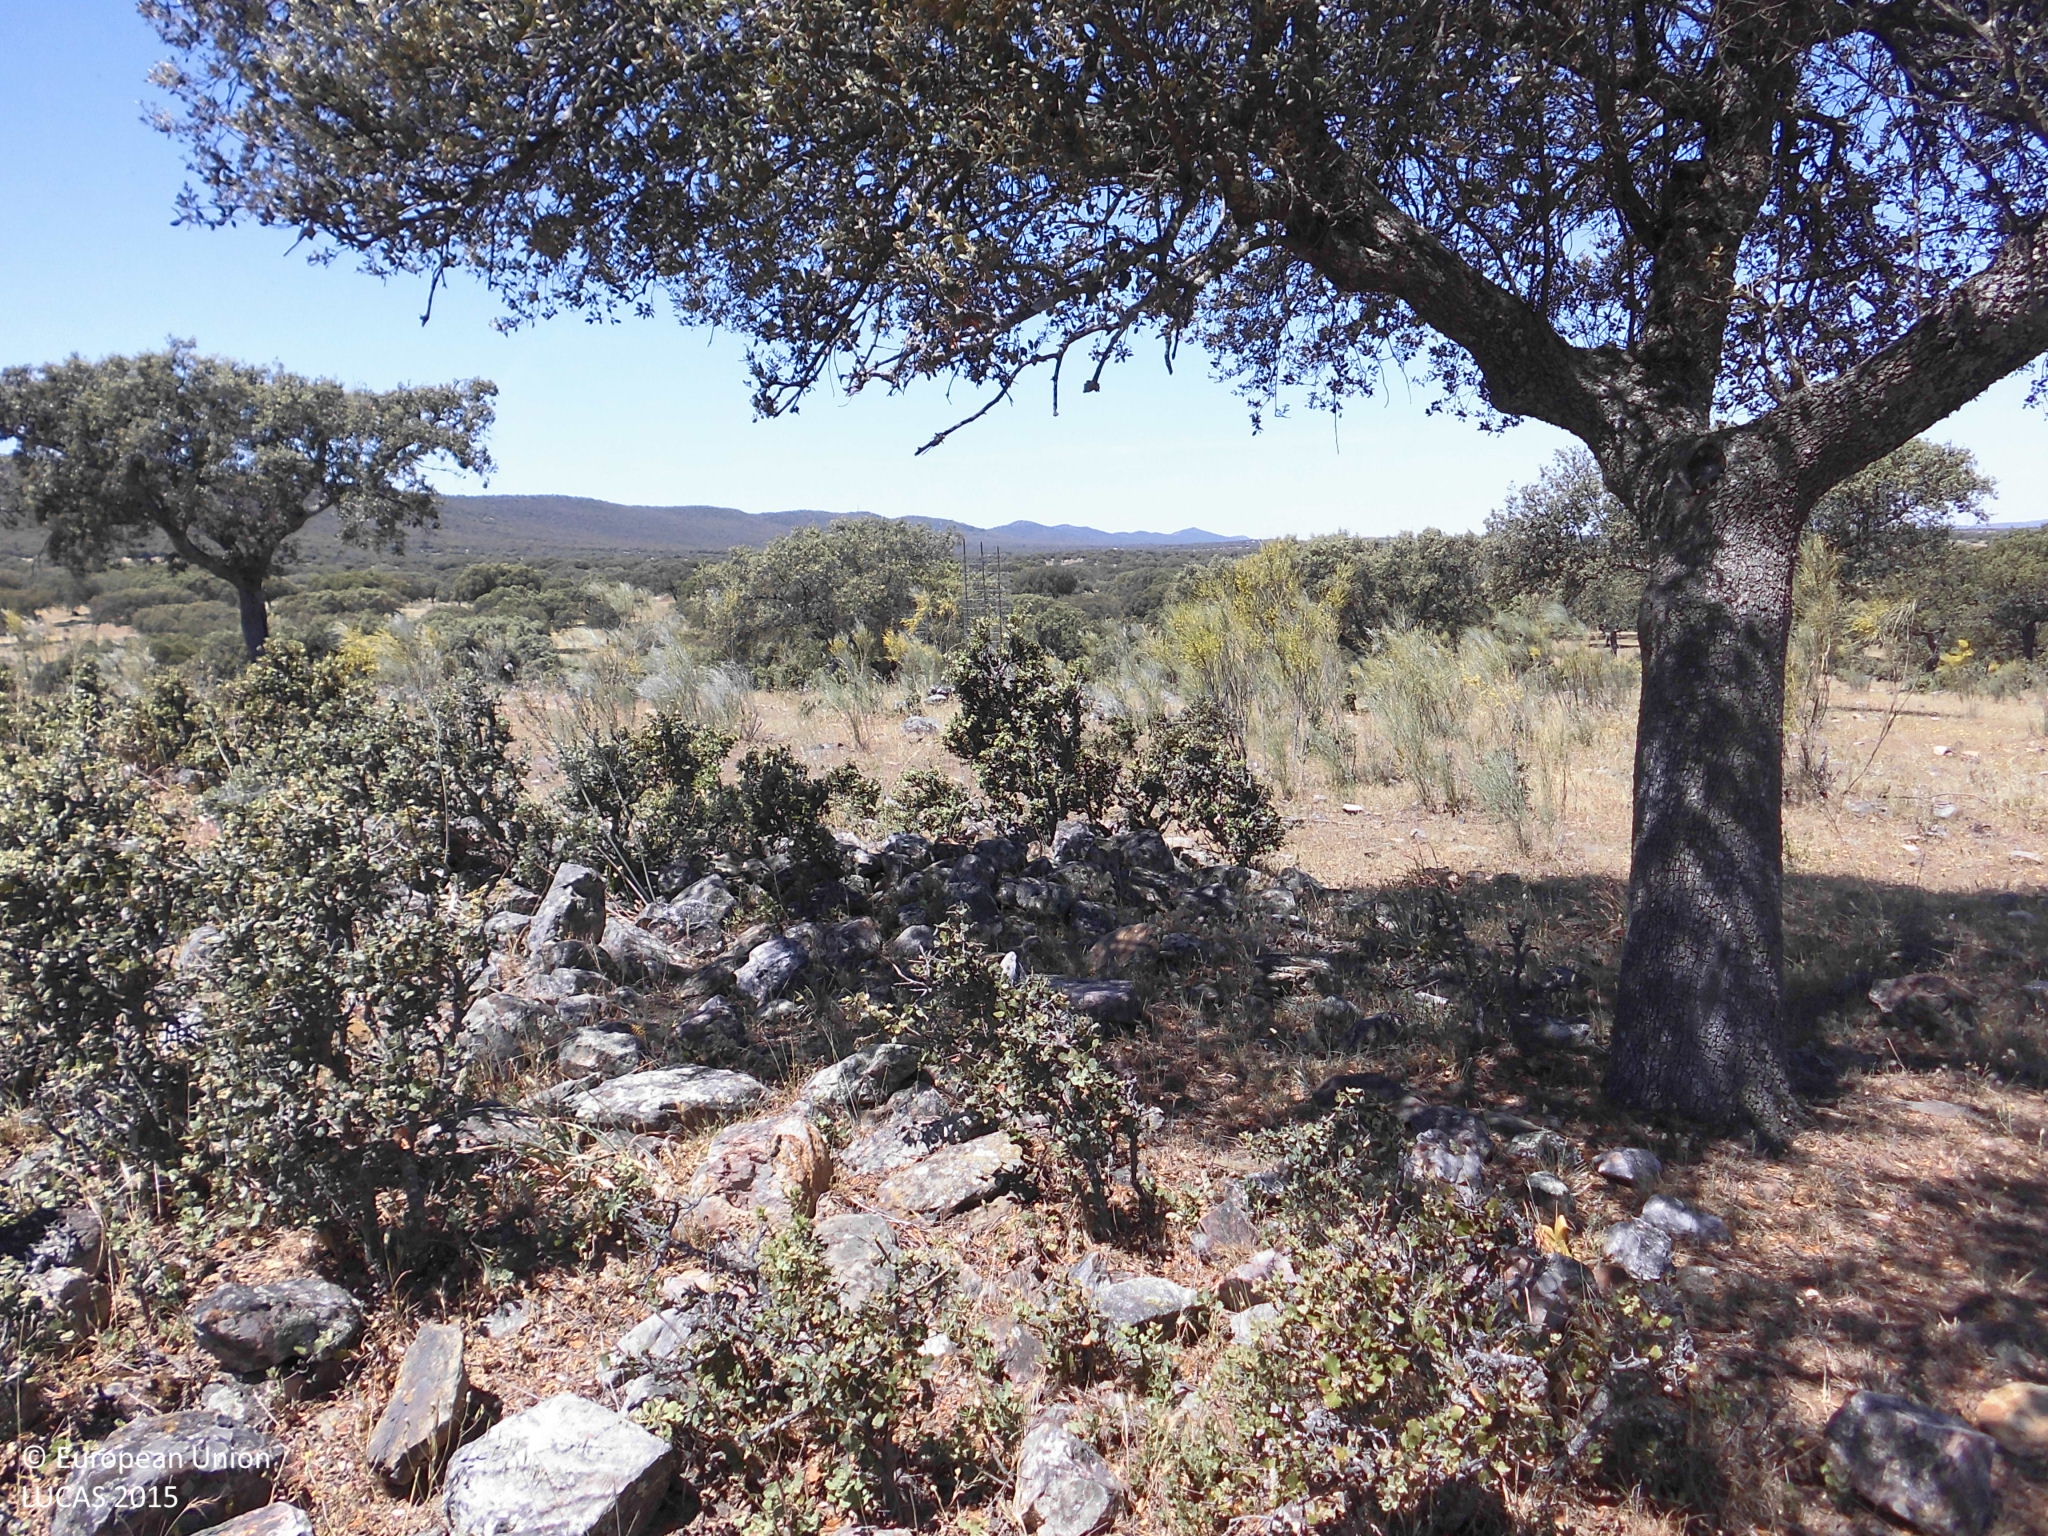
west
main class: Woodland
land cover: Broadleaved woodland
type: broadleaved evergreen forest
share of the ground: 25 - 50 %
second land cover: Grassland without tree/shrub cover
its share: > 75 %
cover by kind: herbaceous plants 50 %, broadleaved forest trees 35 %, shrubs 15 %
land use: Forestry
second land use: Agriculture (excluding fallow land and kitchen gardens)
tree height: > 5 m
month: May
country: ES
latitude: 39.4379
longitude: -6.9854
